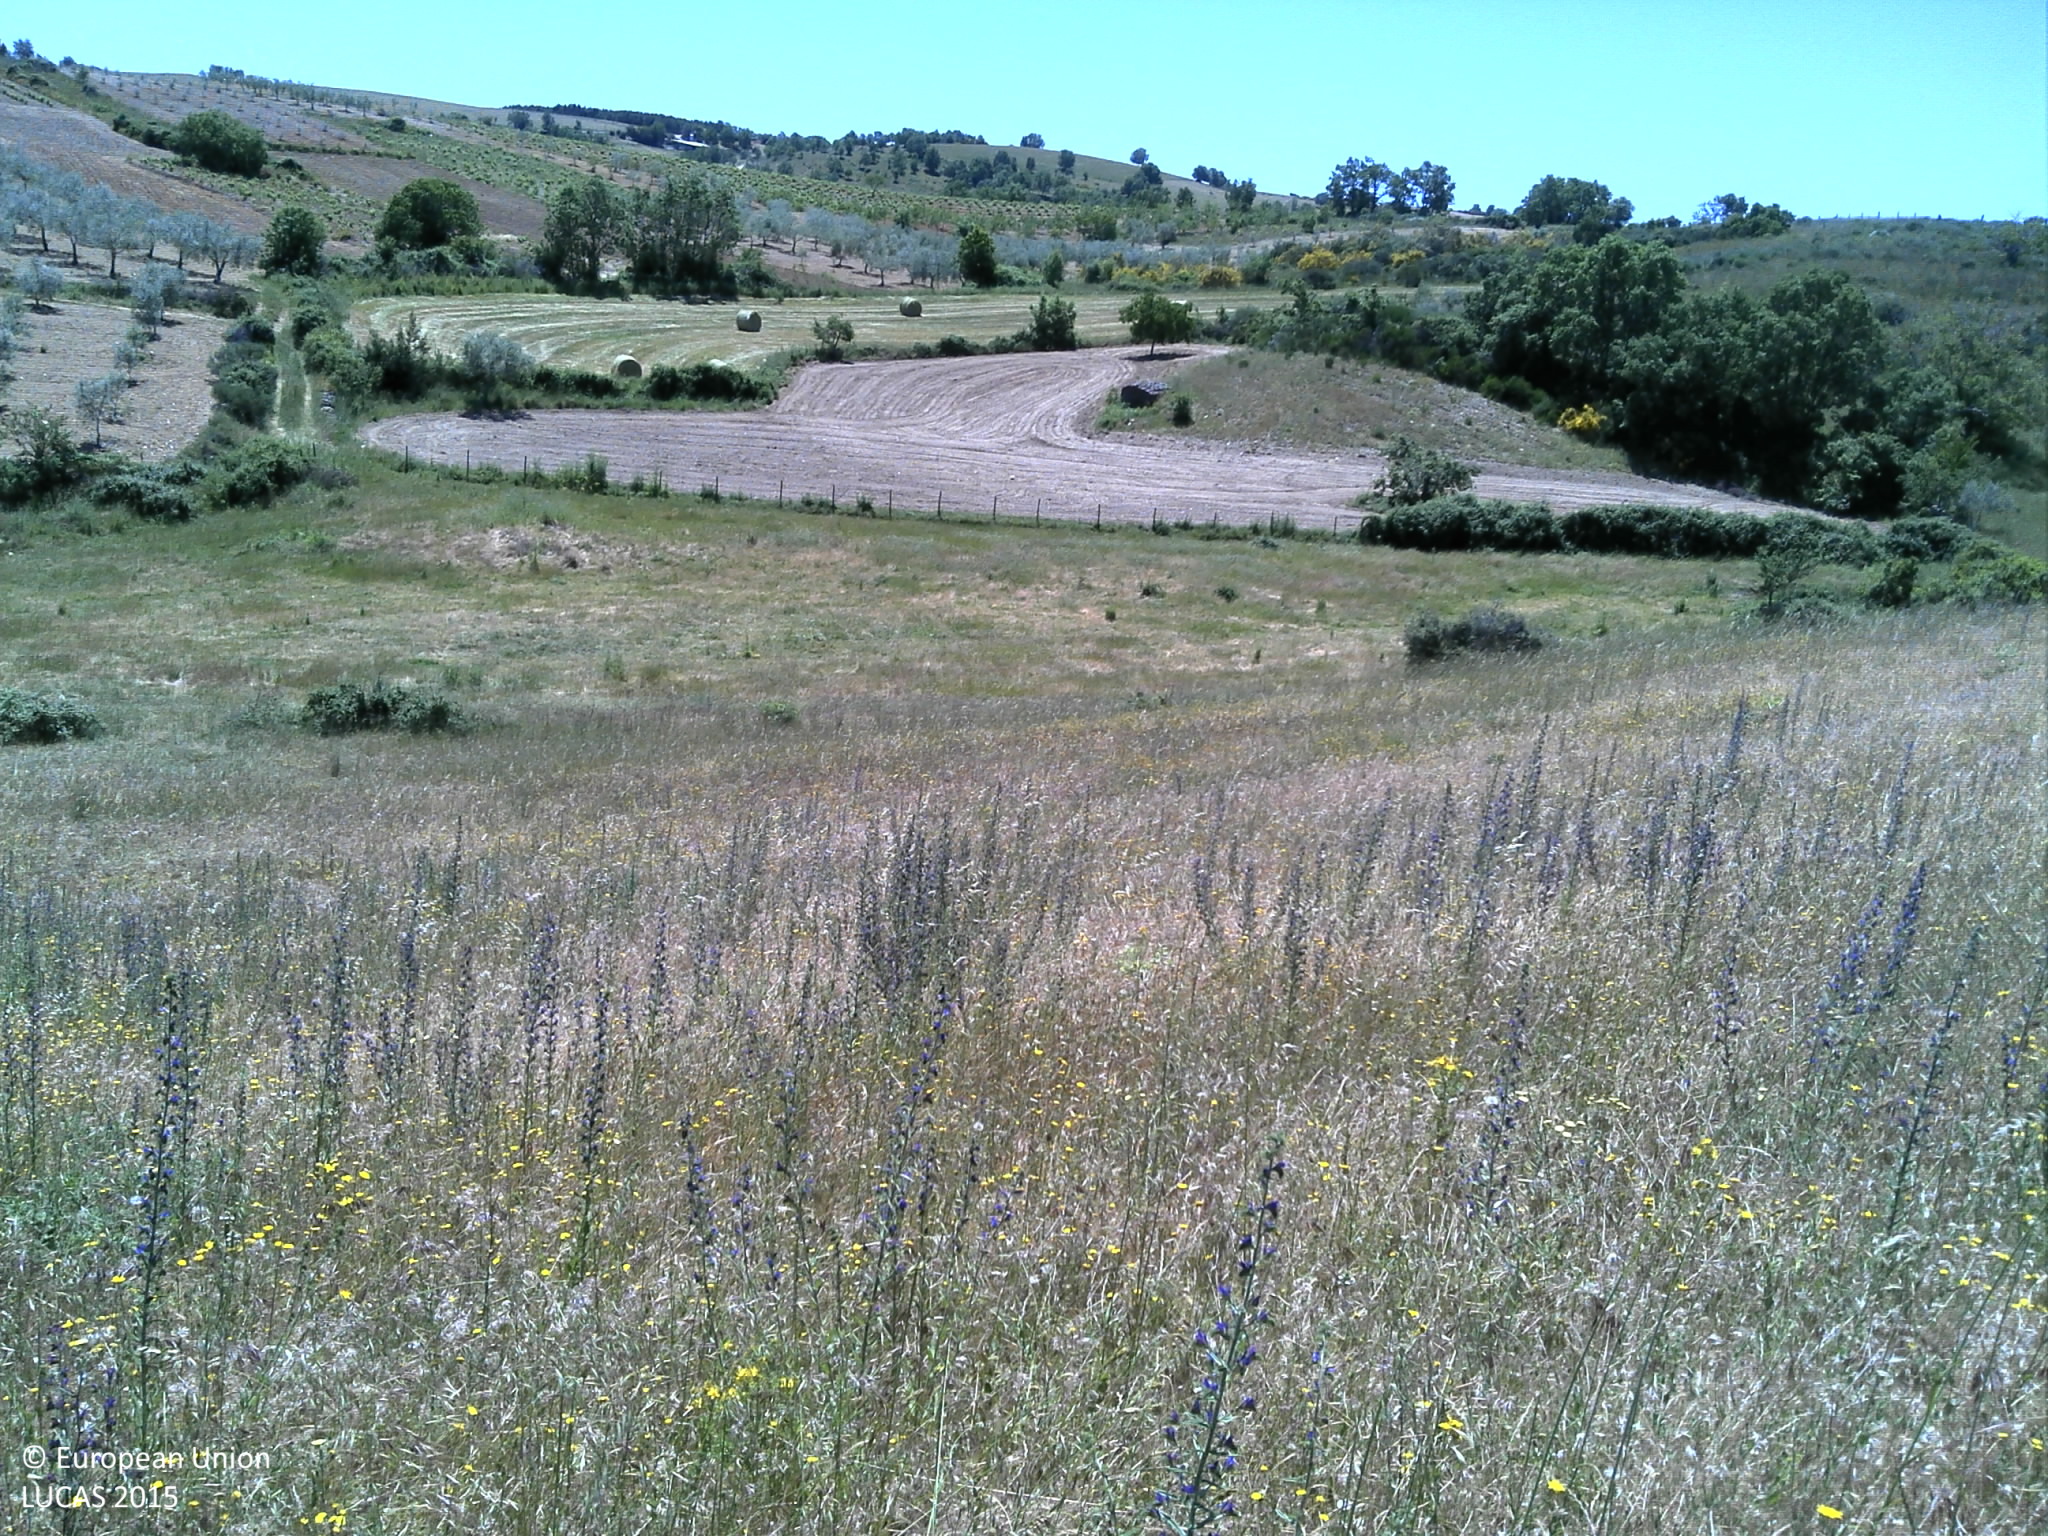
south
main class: Grassland
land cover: Grassland without tree/shrub cover
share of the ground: > 75 %
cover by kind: herbaceous plants 100 %
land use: Agriculture (excluding fallow land and kitchen gardens)
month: May
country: PT
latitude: 41.3924
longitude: -6.5468
